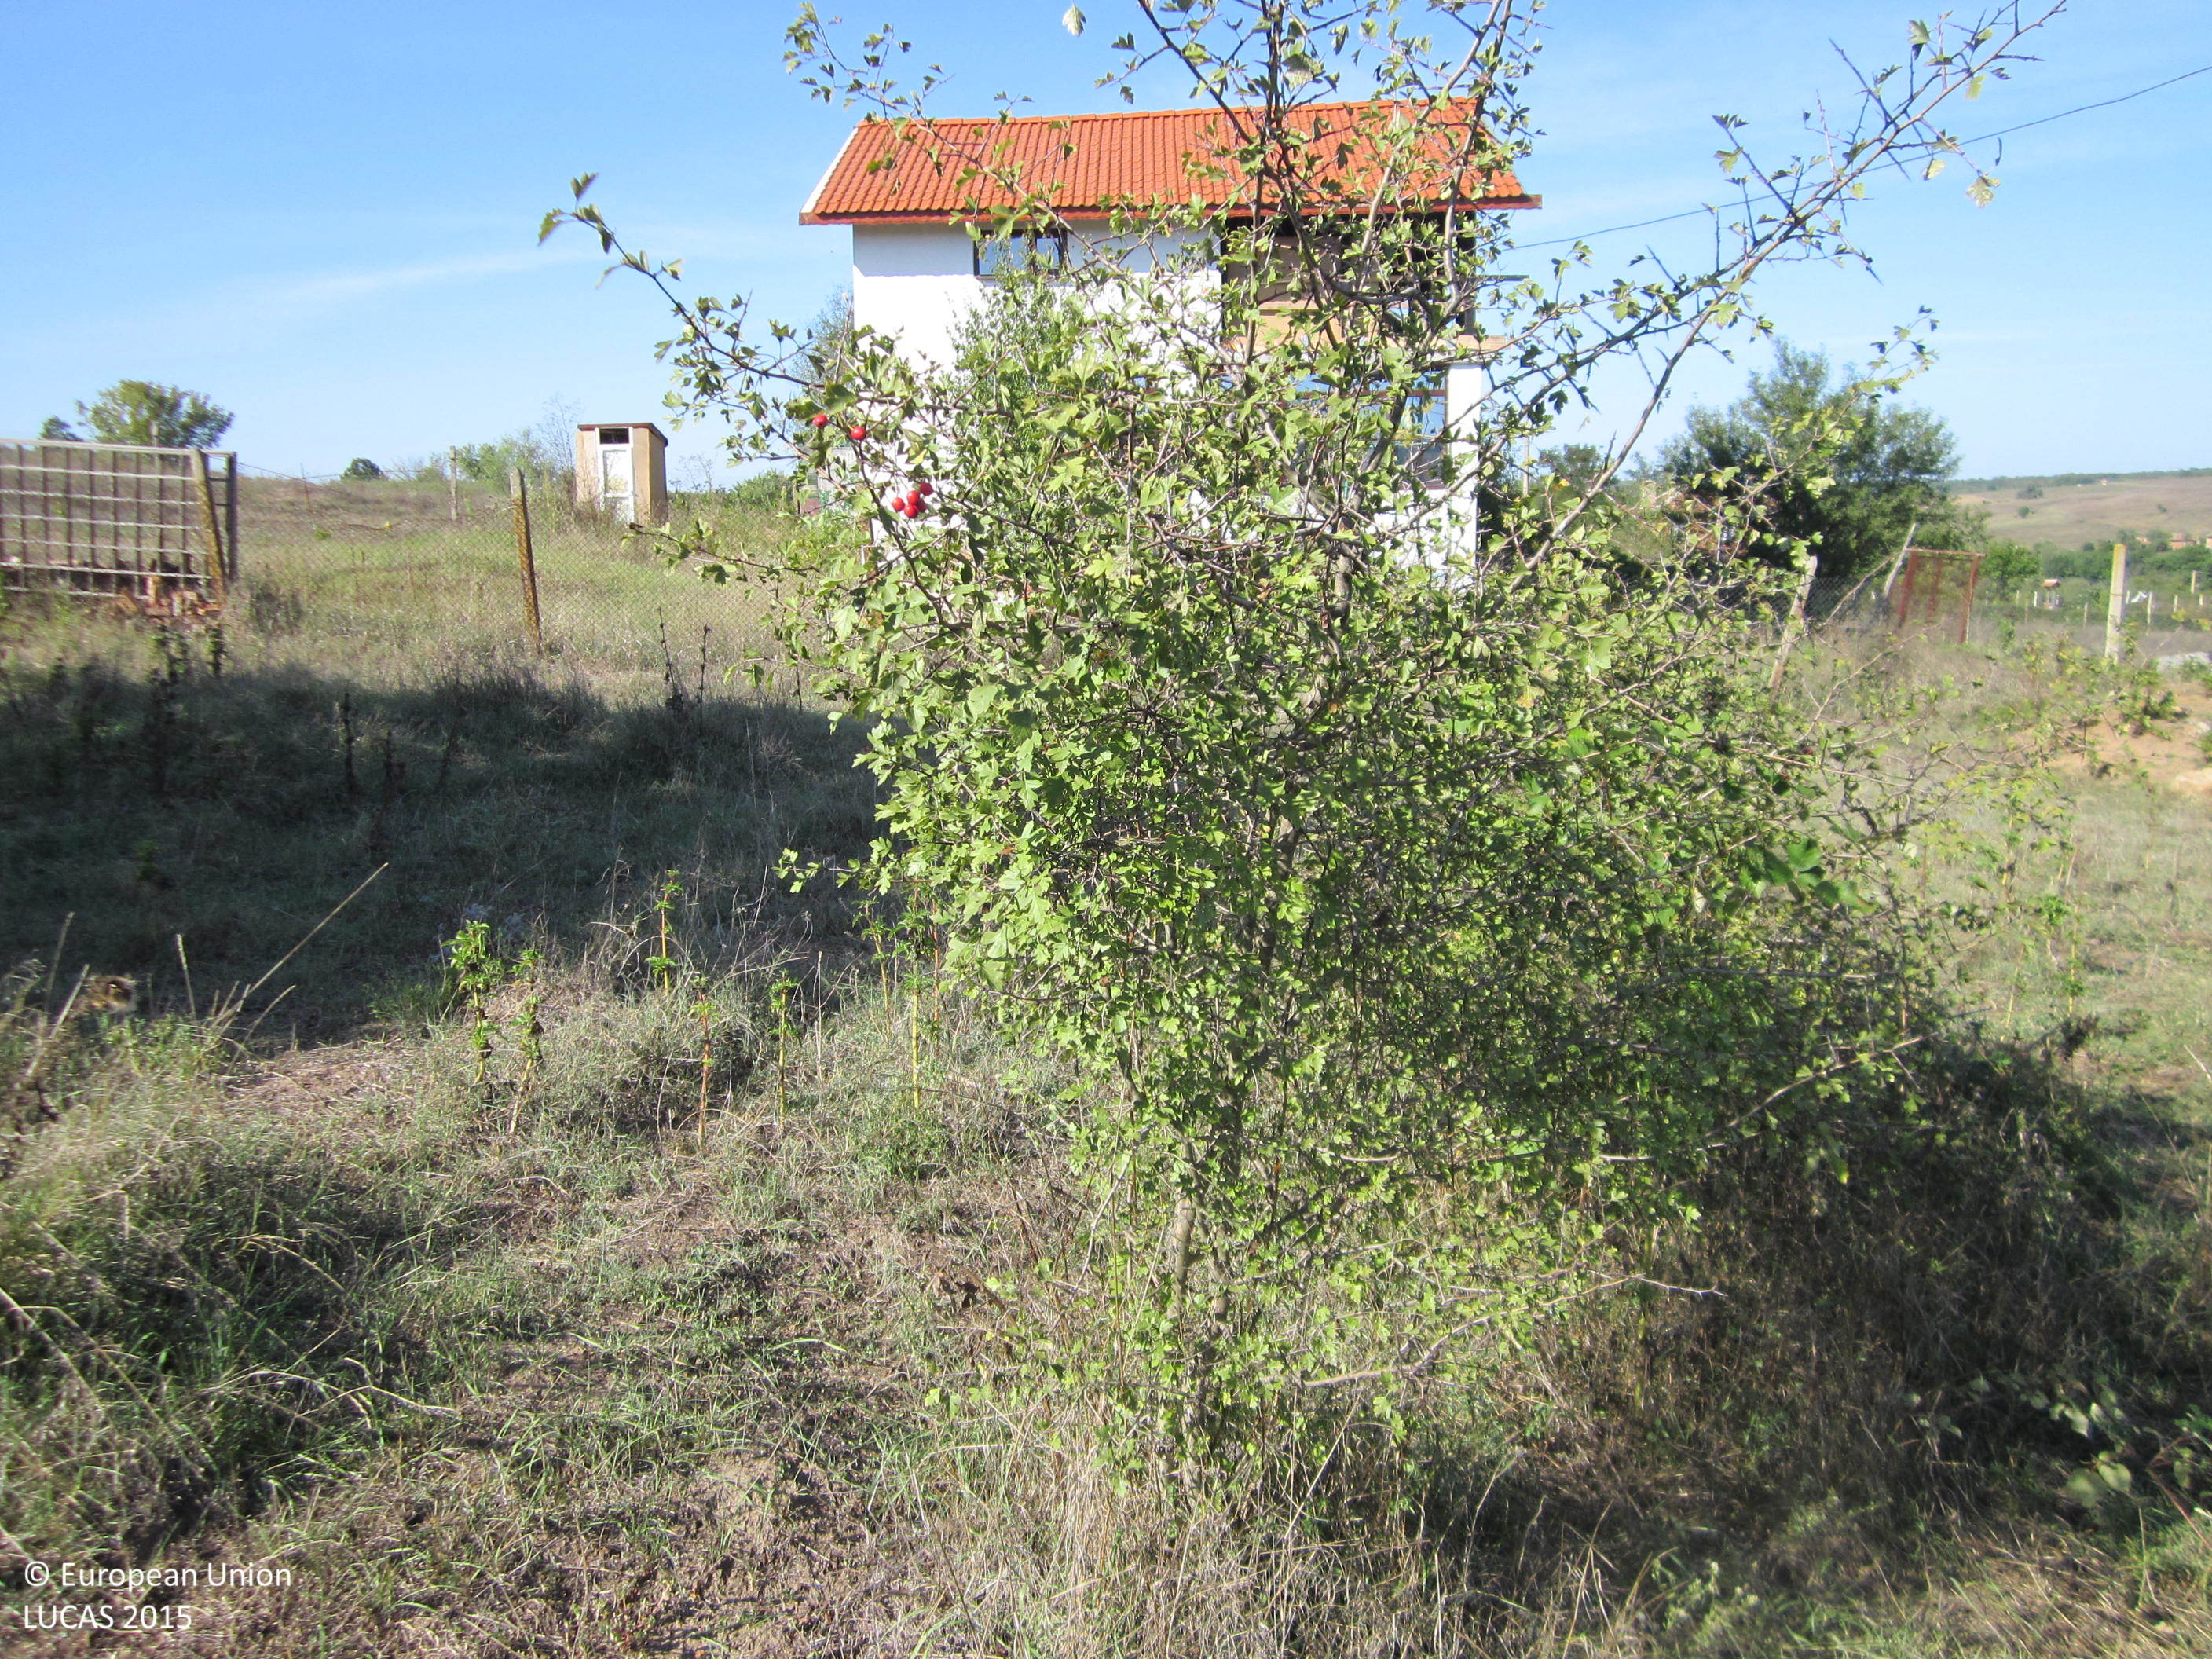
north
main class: Grassland
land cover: Grassland with sparse tree/shrub cover
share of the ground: > 75 %
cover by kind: herbaceous plants 85 %, shrubs 10 %, broadleaved forest trees 5 %
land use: Abandoned areas
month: September
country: BG
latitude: 42.2618
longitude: 27.0625
